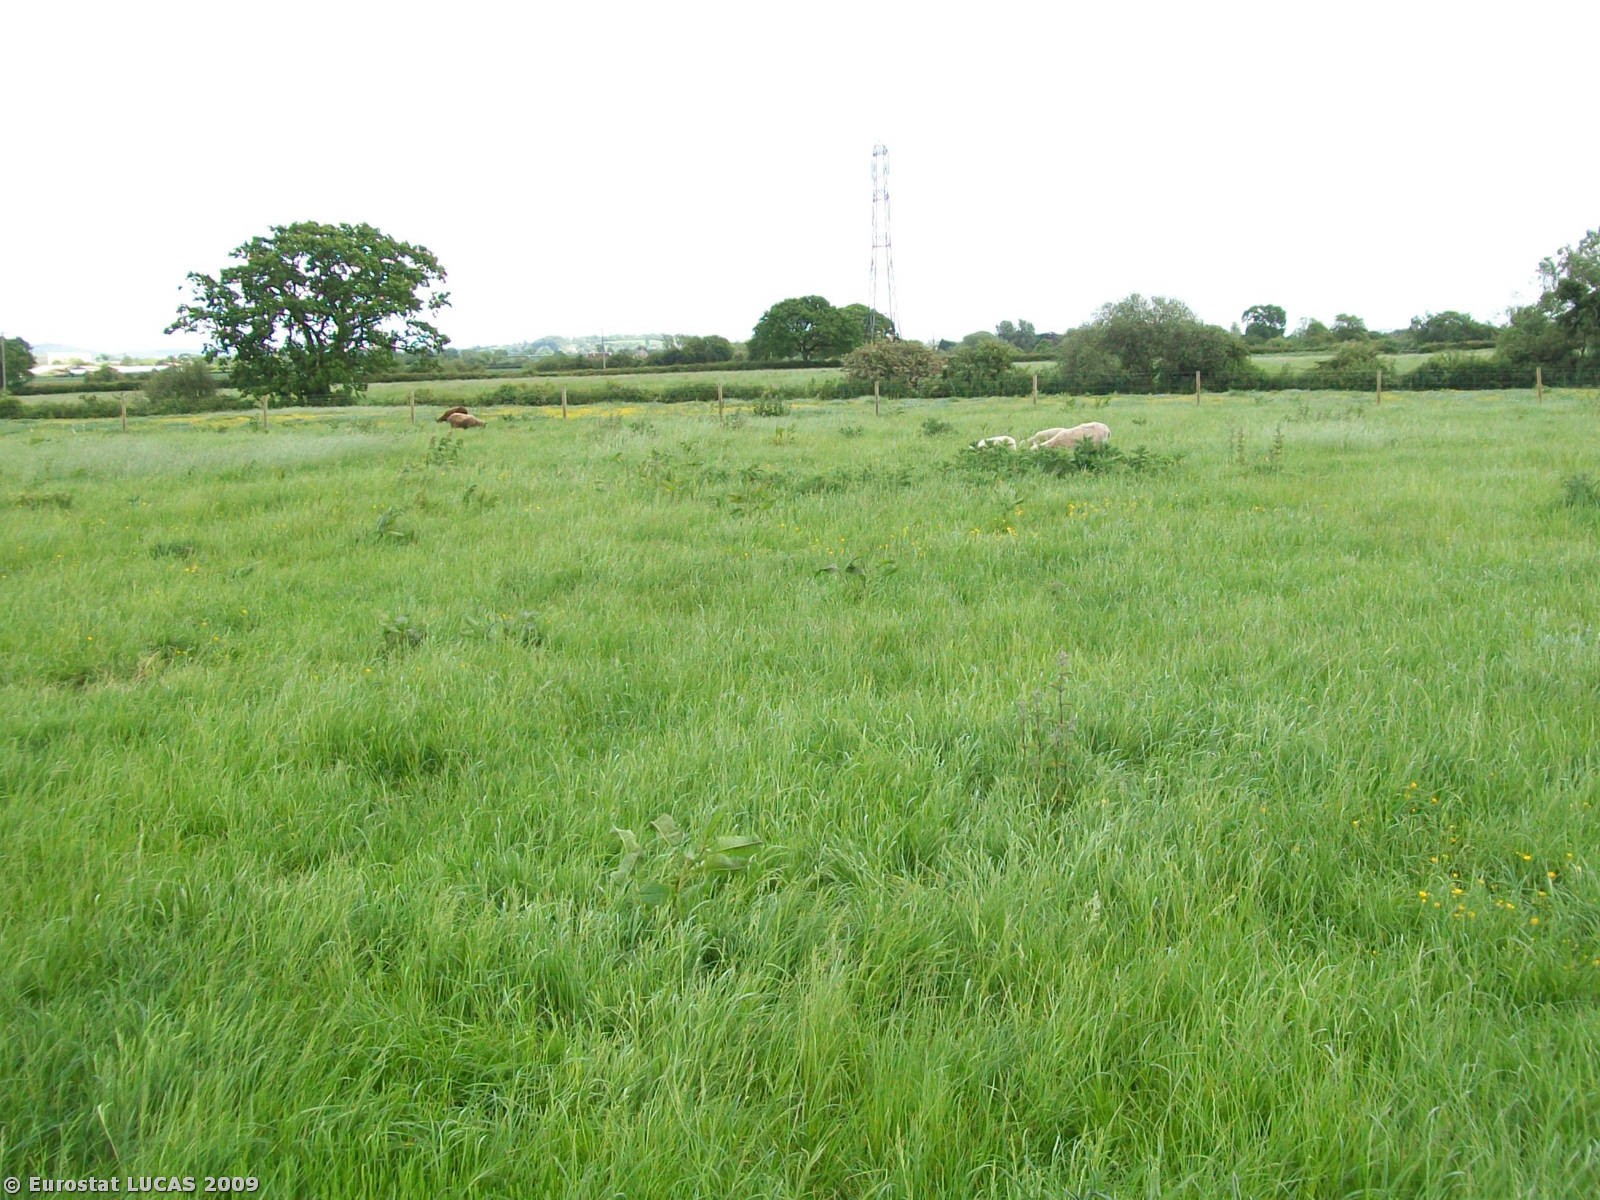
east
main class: Grassland
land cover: Grassland without tree/shrub cover
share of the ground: > 75 %
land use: Agriculture (excluding fallow land and kitchen gardens)
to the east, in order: Grassland without tree/shrub cover; Fences; Grassland without tree/shrub cover; Fences; Abandoned hedges; Spontaneously vegetated surfaces; Grassland without tree/shrub cover
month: May
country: GB
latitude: 51.3488
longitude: -2.1648
